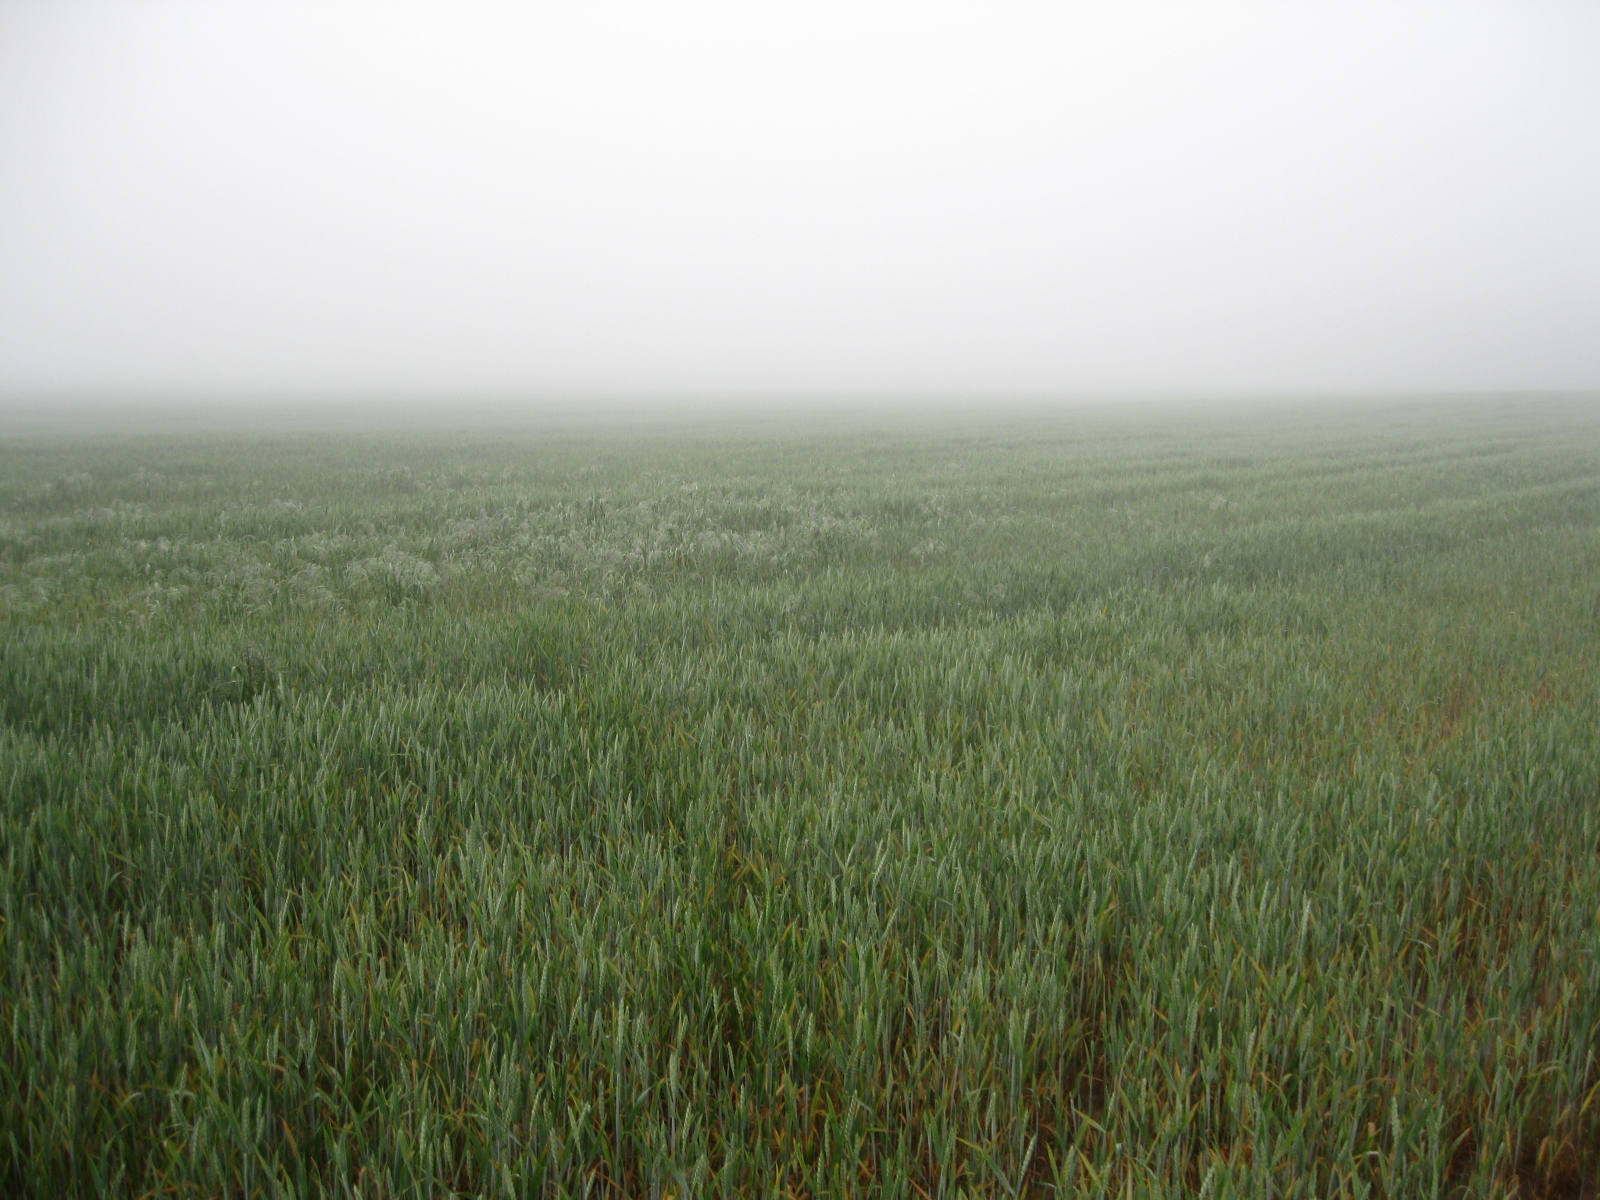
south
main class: Cropland
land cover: Common wheat
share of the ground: > 75 %
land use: Agriculture (excluding fallow land and kitchen gardens)
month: June
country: LT
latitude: 55.4353
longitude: 23.9814
